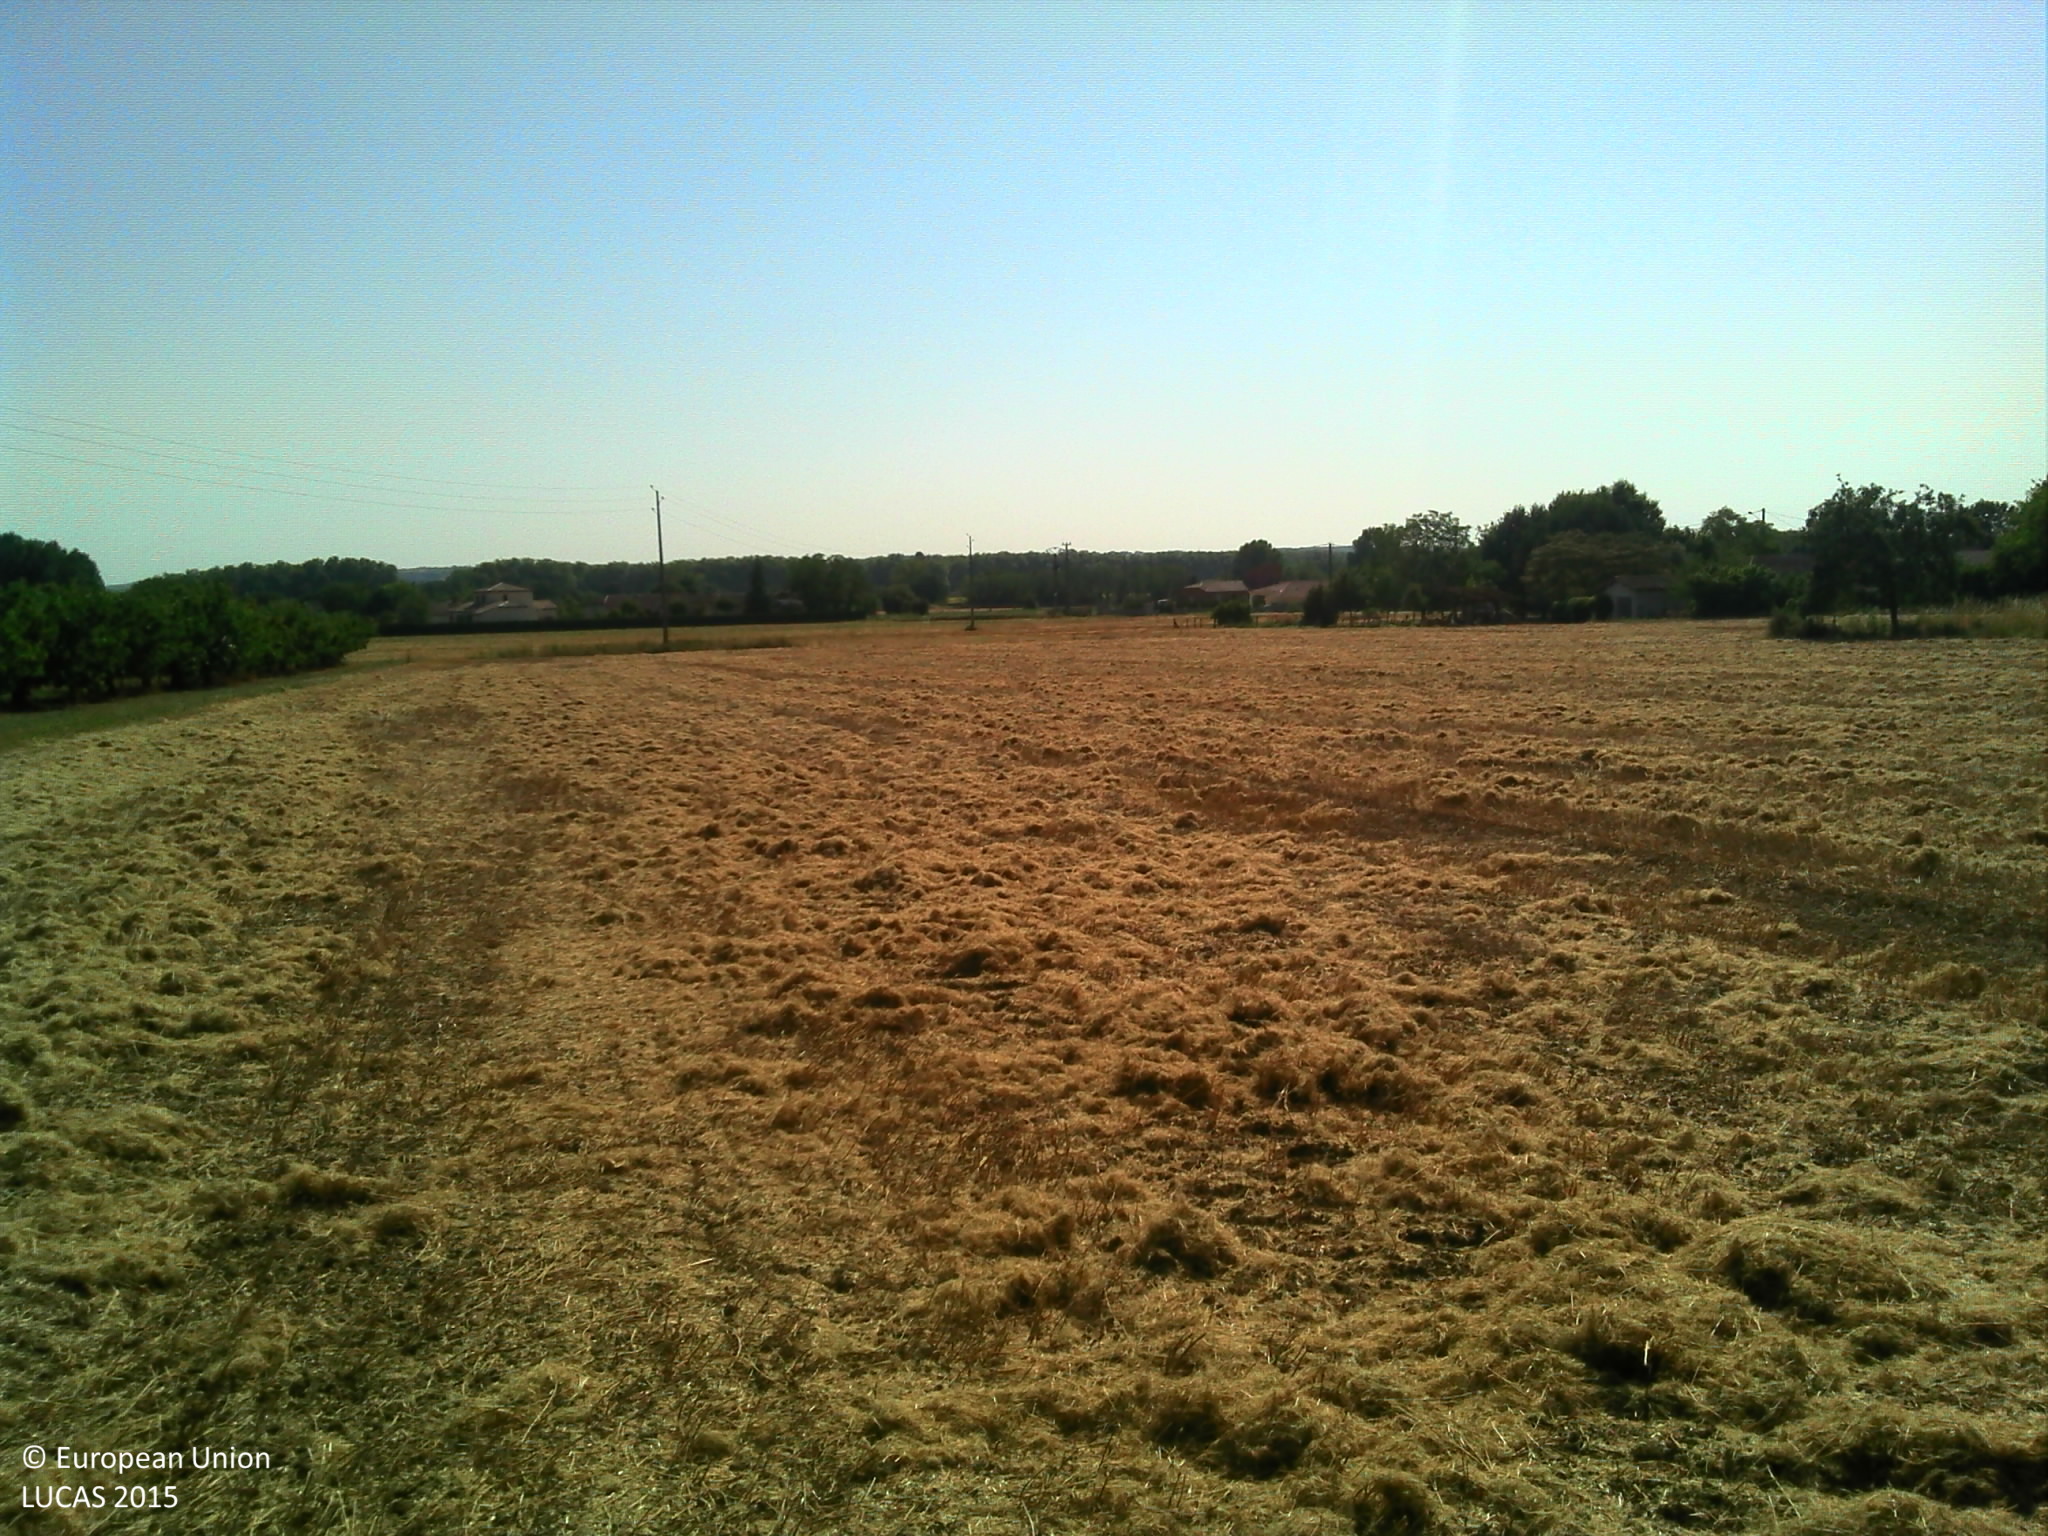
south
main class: Cropland
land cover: Common wheat
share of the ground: 50 - 75 %
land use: Agriculture (excluding fallow land and kitchen gardens)
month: July
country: FR
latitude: 44.1009
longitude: 0.9656
